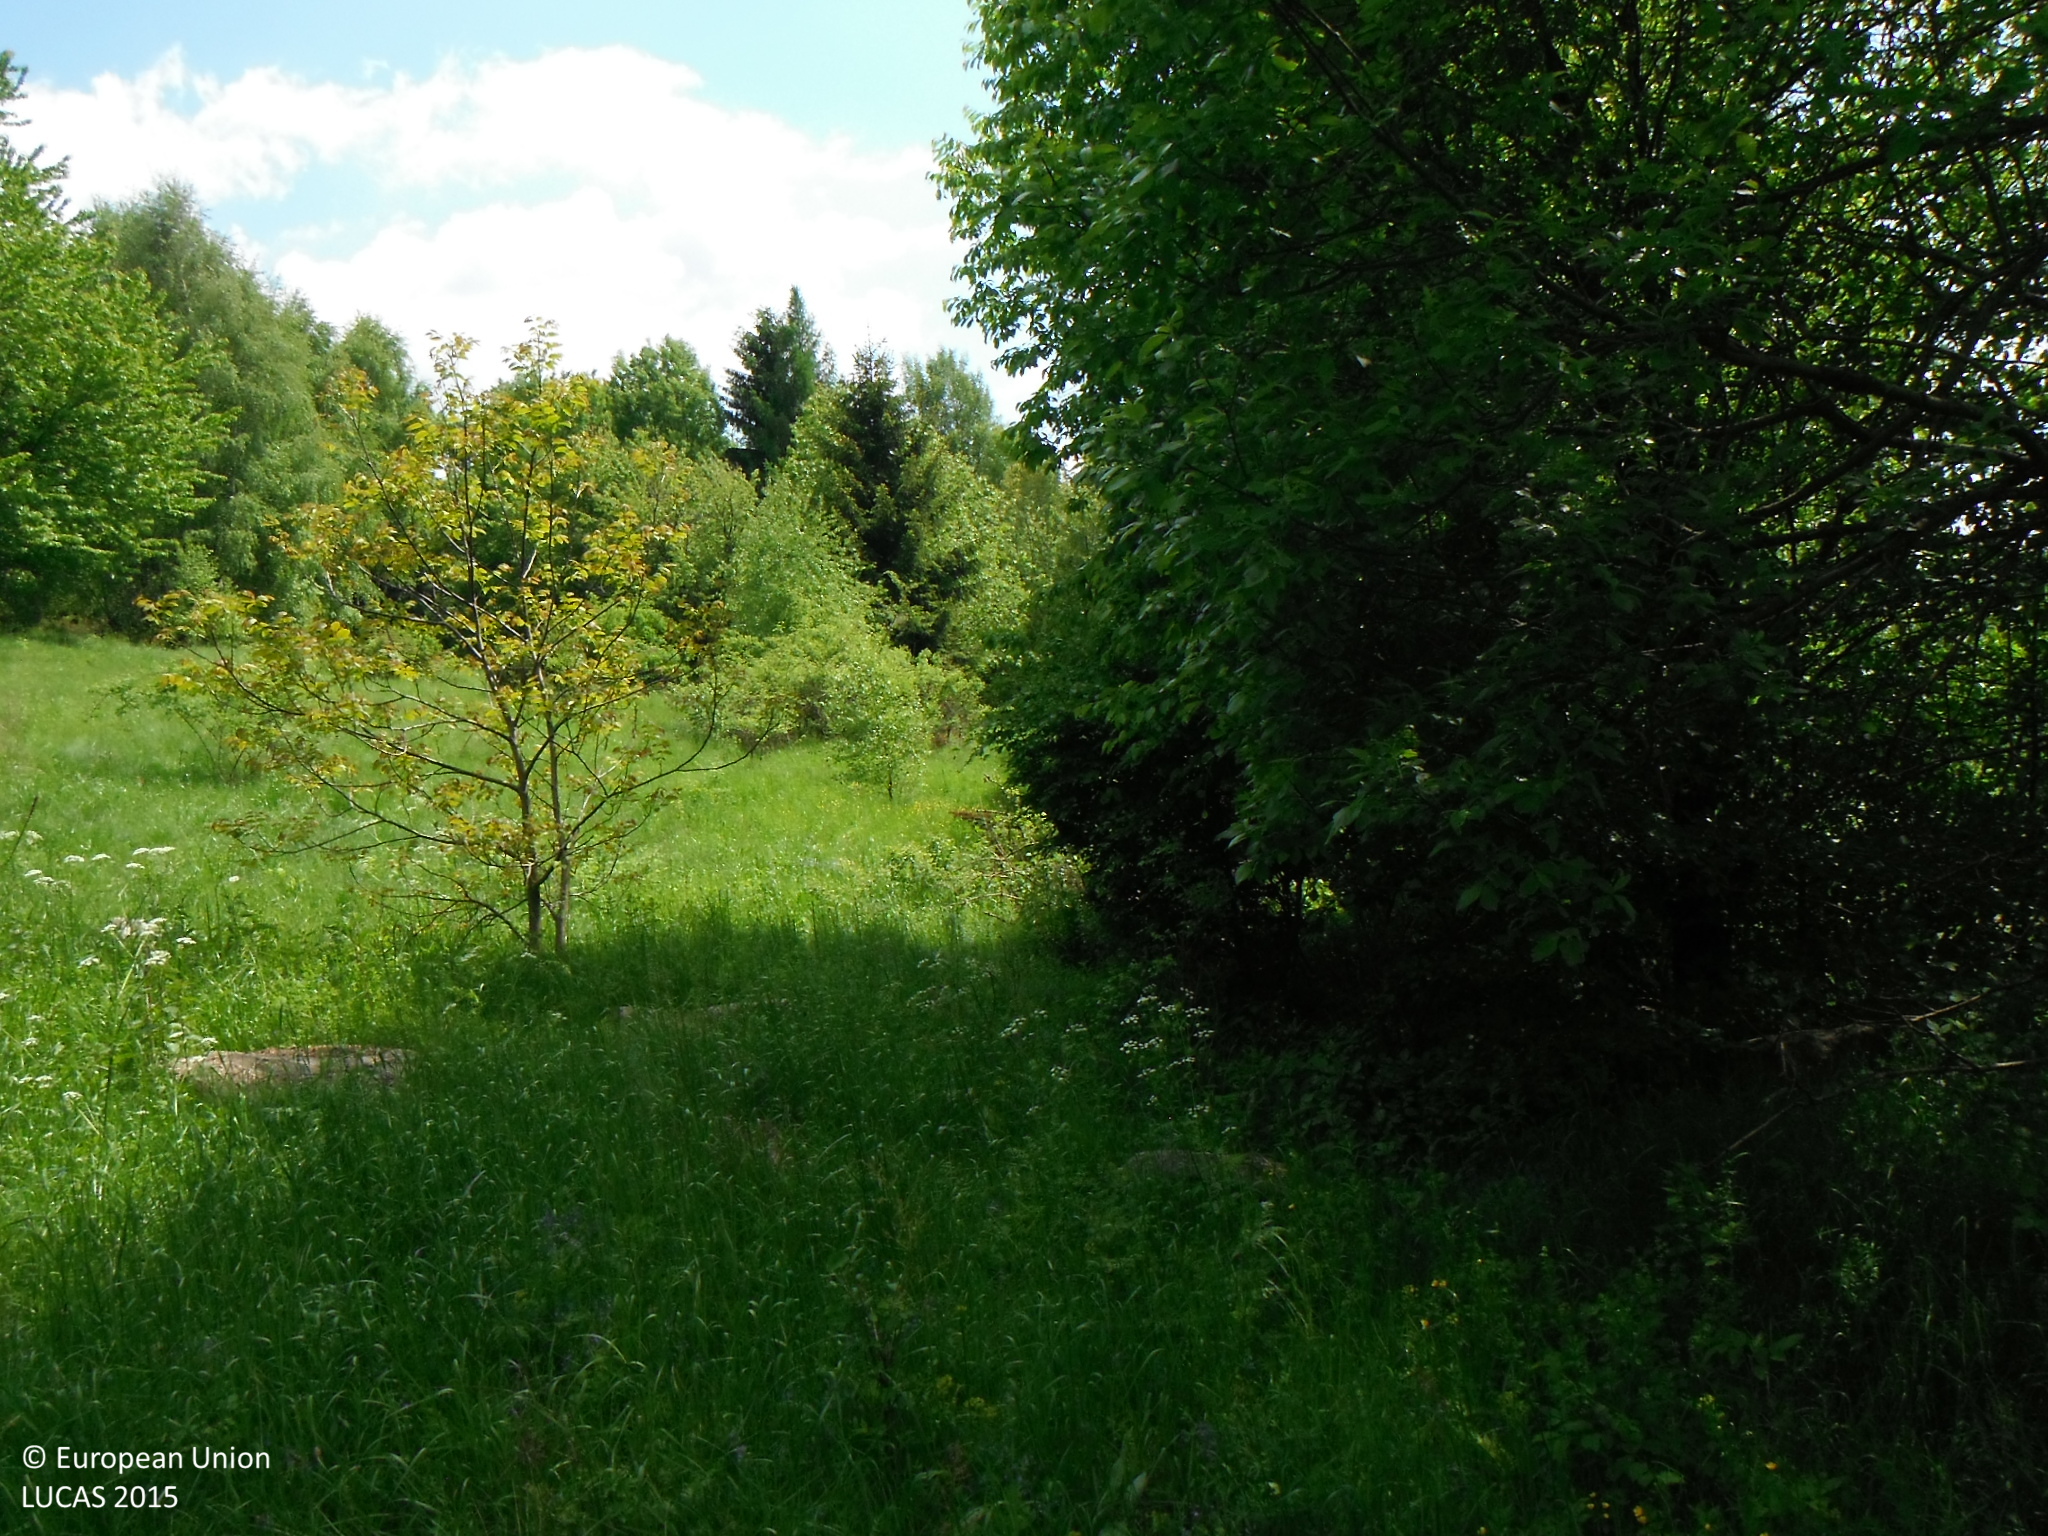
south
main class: Grassland
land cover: Grassland with sparse tree/shrub cover
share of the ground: > 75 %
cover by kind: herbaceous plants 90 %, broadleaved forest trees 5 %, shrubs 5 %
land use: Agriculture (excluding fallow land and kitchen gardens)
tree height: > 5 m
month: May
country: SK
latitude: 48.5285
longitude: 19.5995
